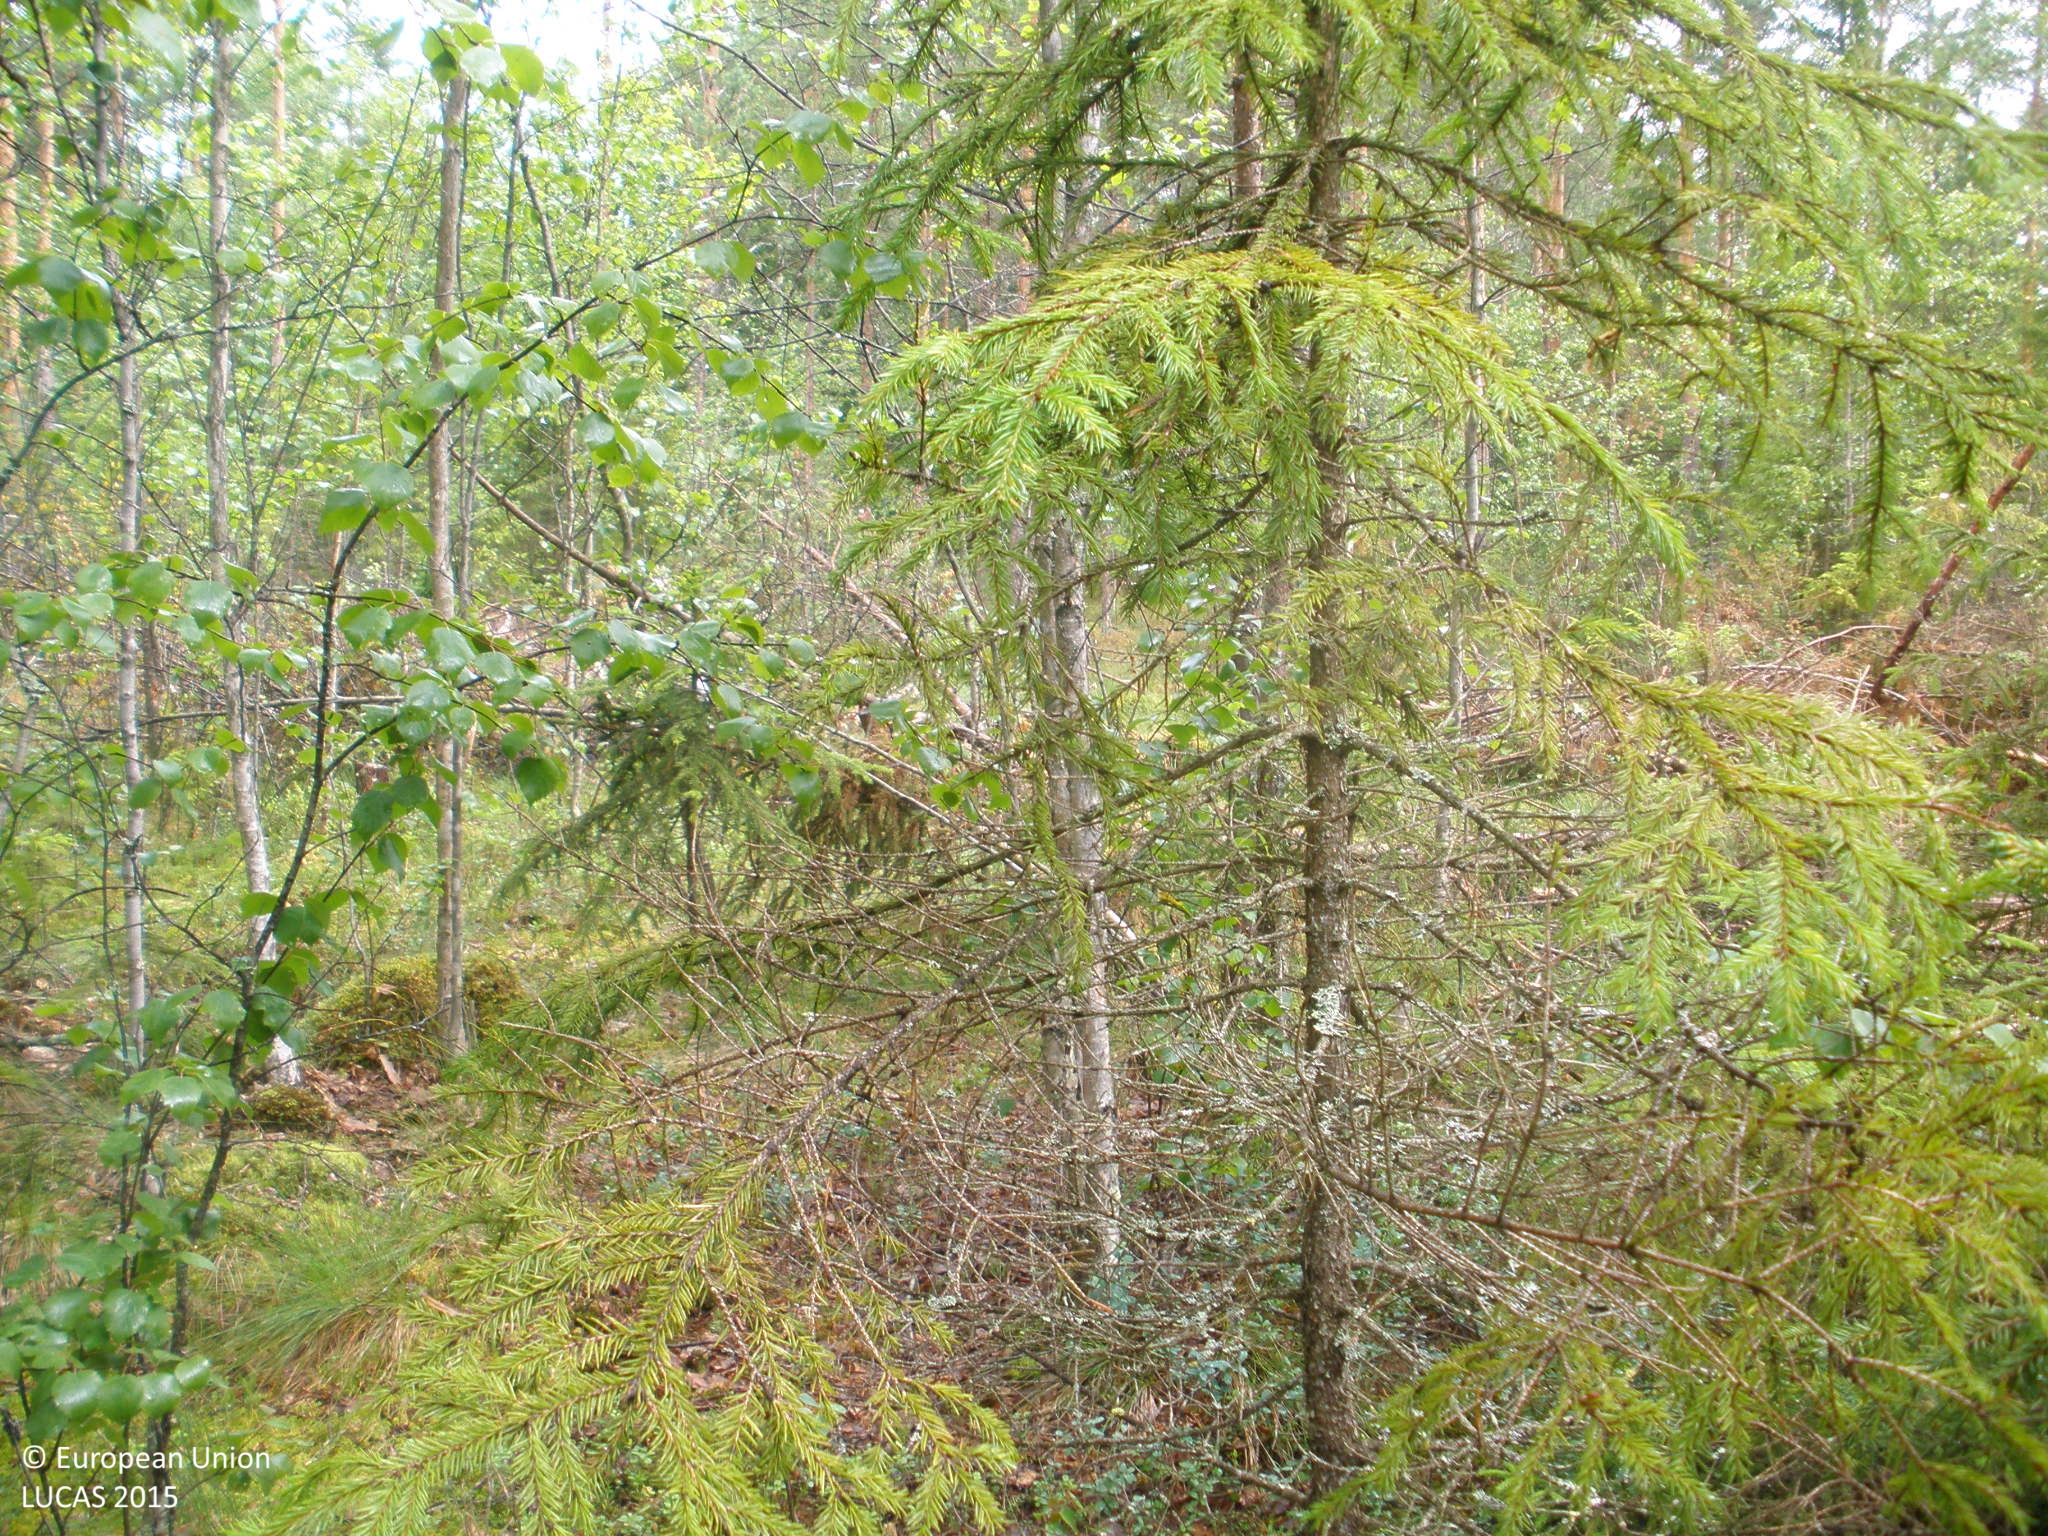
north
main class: Woodland
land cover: Pine dominated mixed woodland
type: boreal forest
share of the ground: > 75 %
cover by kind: coniferous forest trees 60 %, broadleaved forest trees 25 %, lichens and mosses 10 %, shrubs 5 %
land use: Forestry
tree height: > 5 m
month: July
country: FI
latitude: 61.0290
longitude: 24.9744
